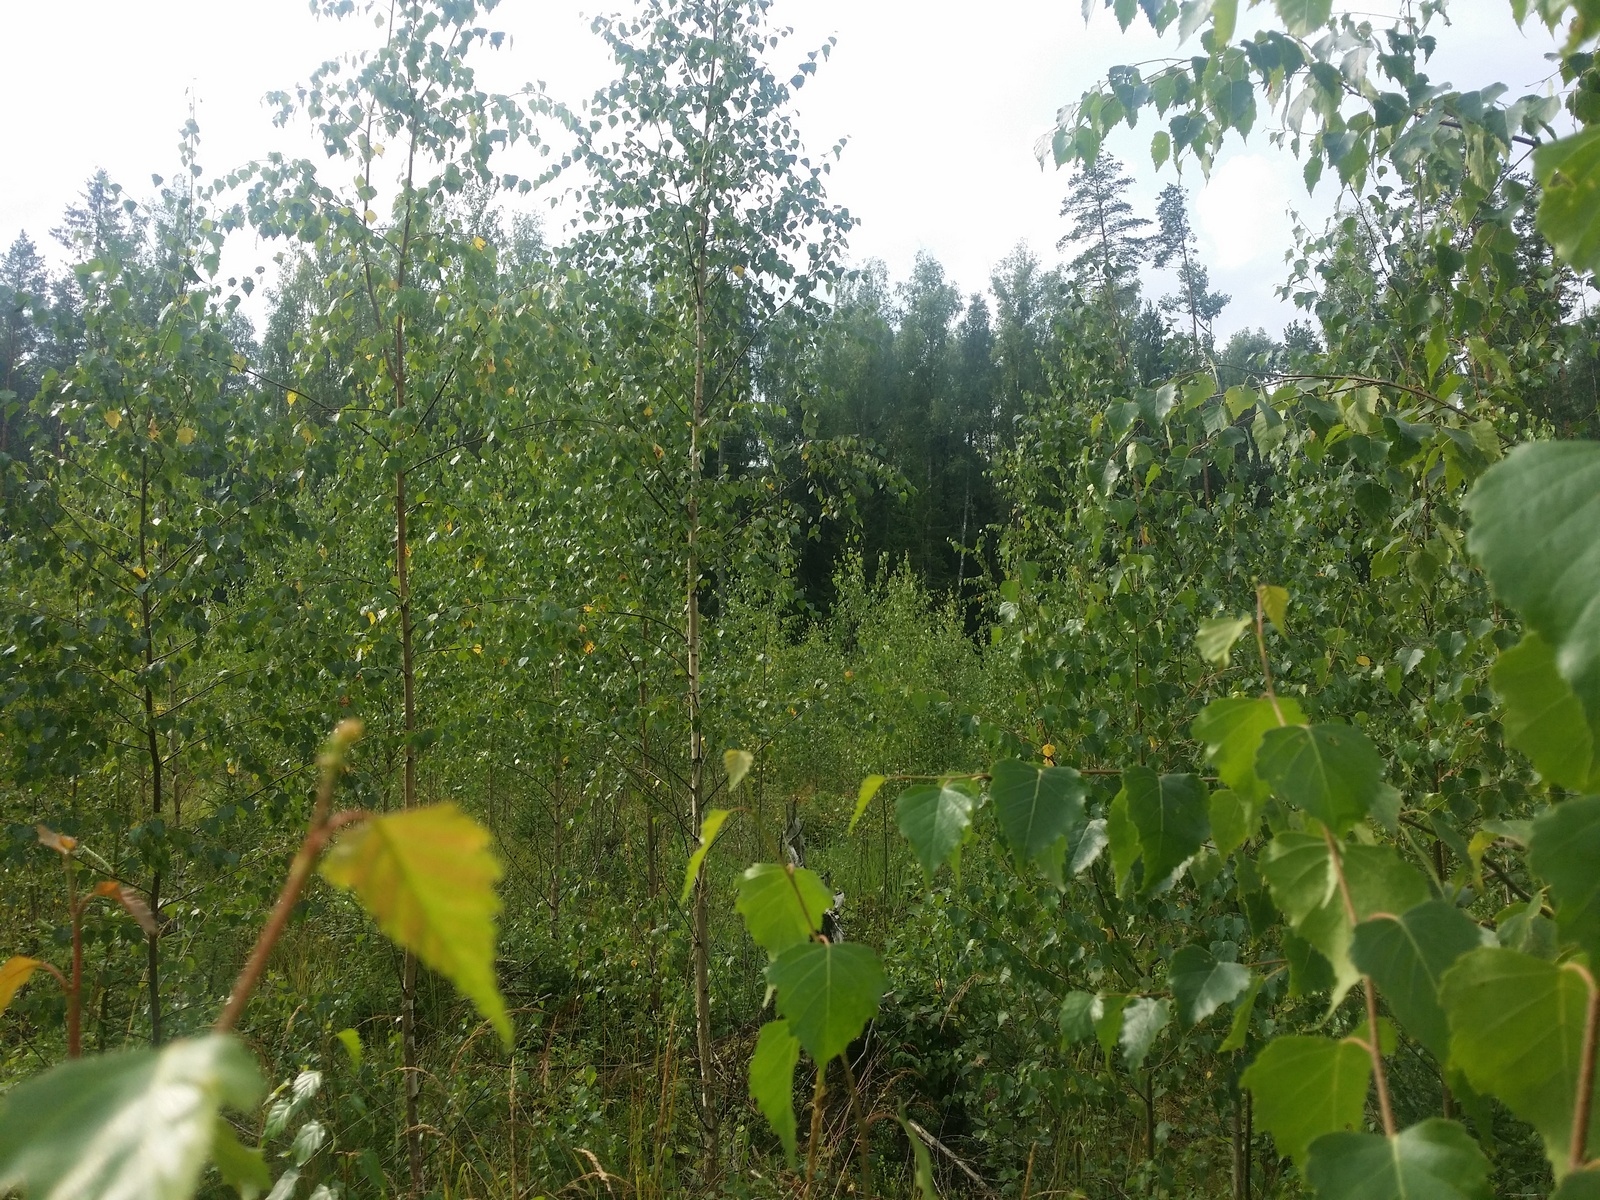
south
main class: Woodland
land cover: Broadleaved woodland
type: non-riverine alder, birch or aspen forest
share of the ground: 50 - 75 %
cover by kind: broadleaved forest trees 70 %, shrubs 20 %, herbaceous plants 10 %
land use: Forestry
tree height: < 5 m
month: August
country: LV
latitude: 57.4827
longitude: 26.5052
